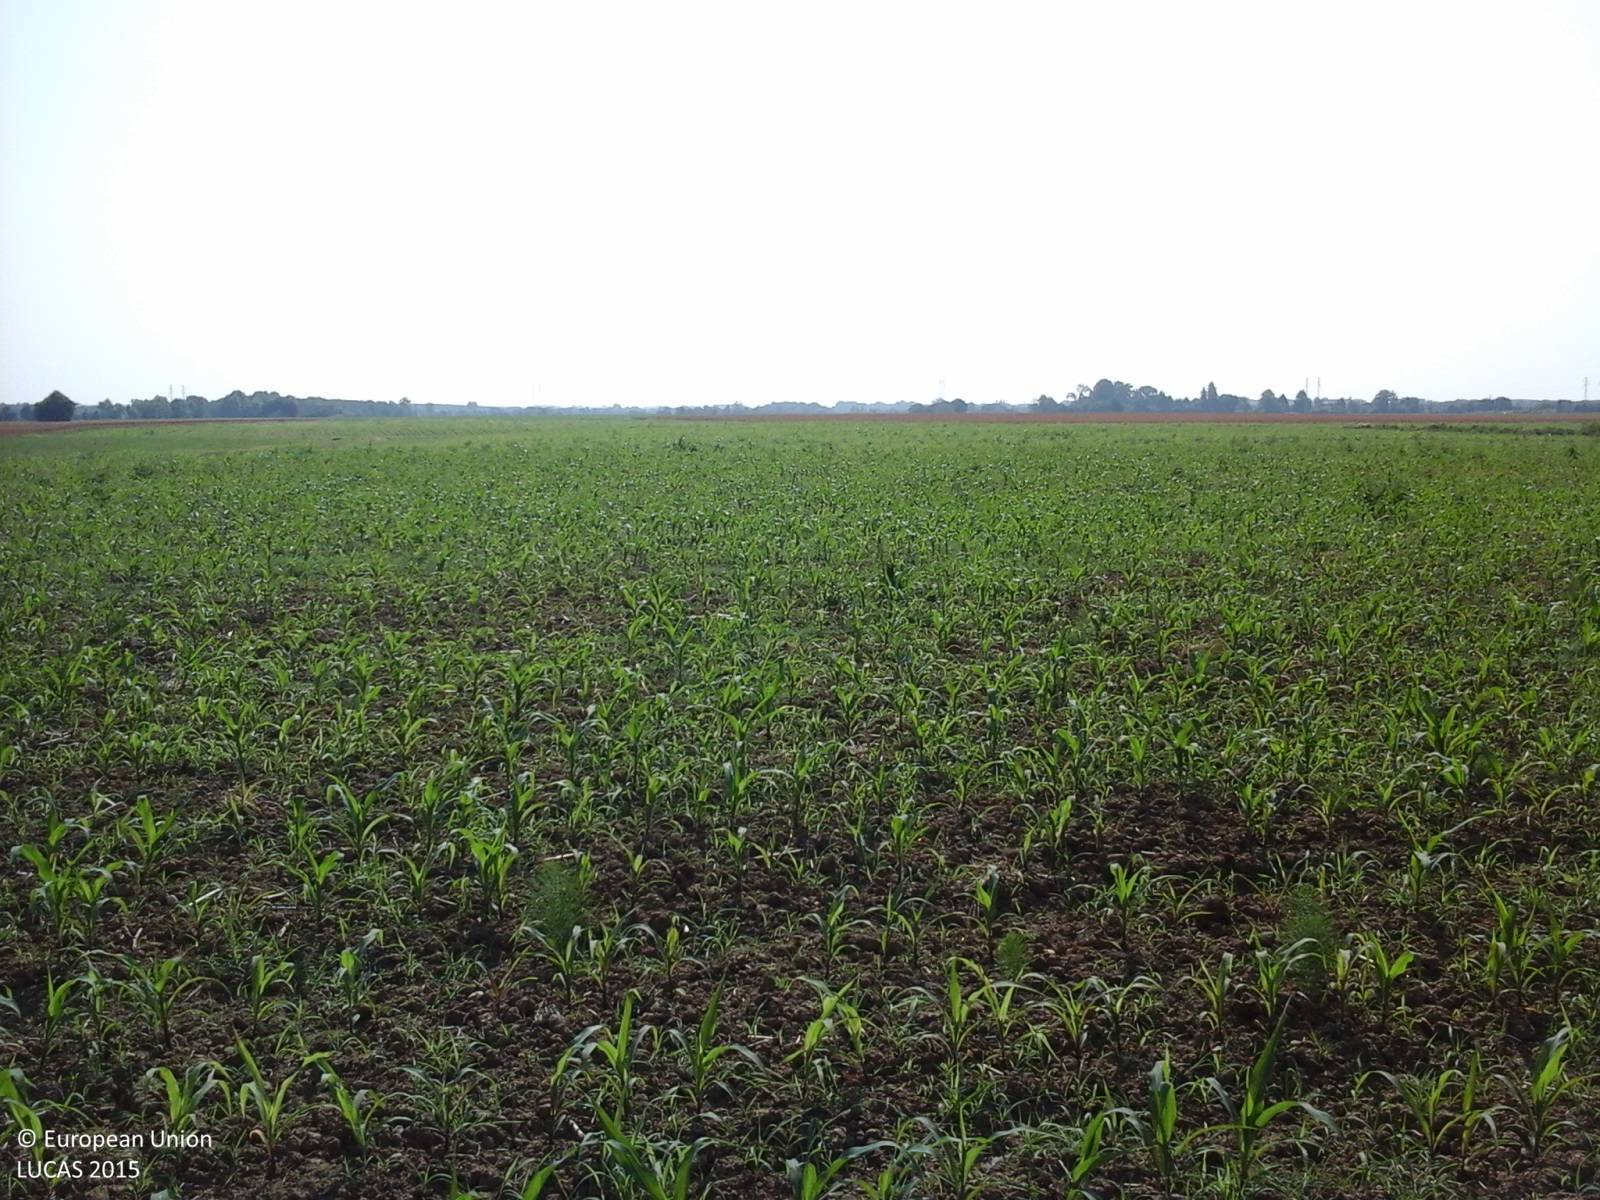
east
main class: Cropland
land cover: Maize
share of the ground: < 10 %
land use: Agriculture (excluding fallow land and kitchen gardens)
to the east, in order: Maize; Soya; Tracks; Soya
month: June
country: IT
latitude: 45.9625
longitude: 12.4614
